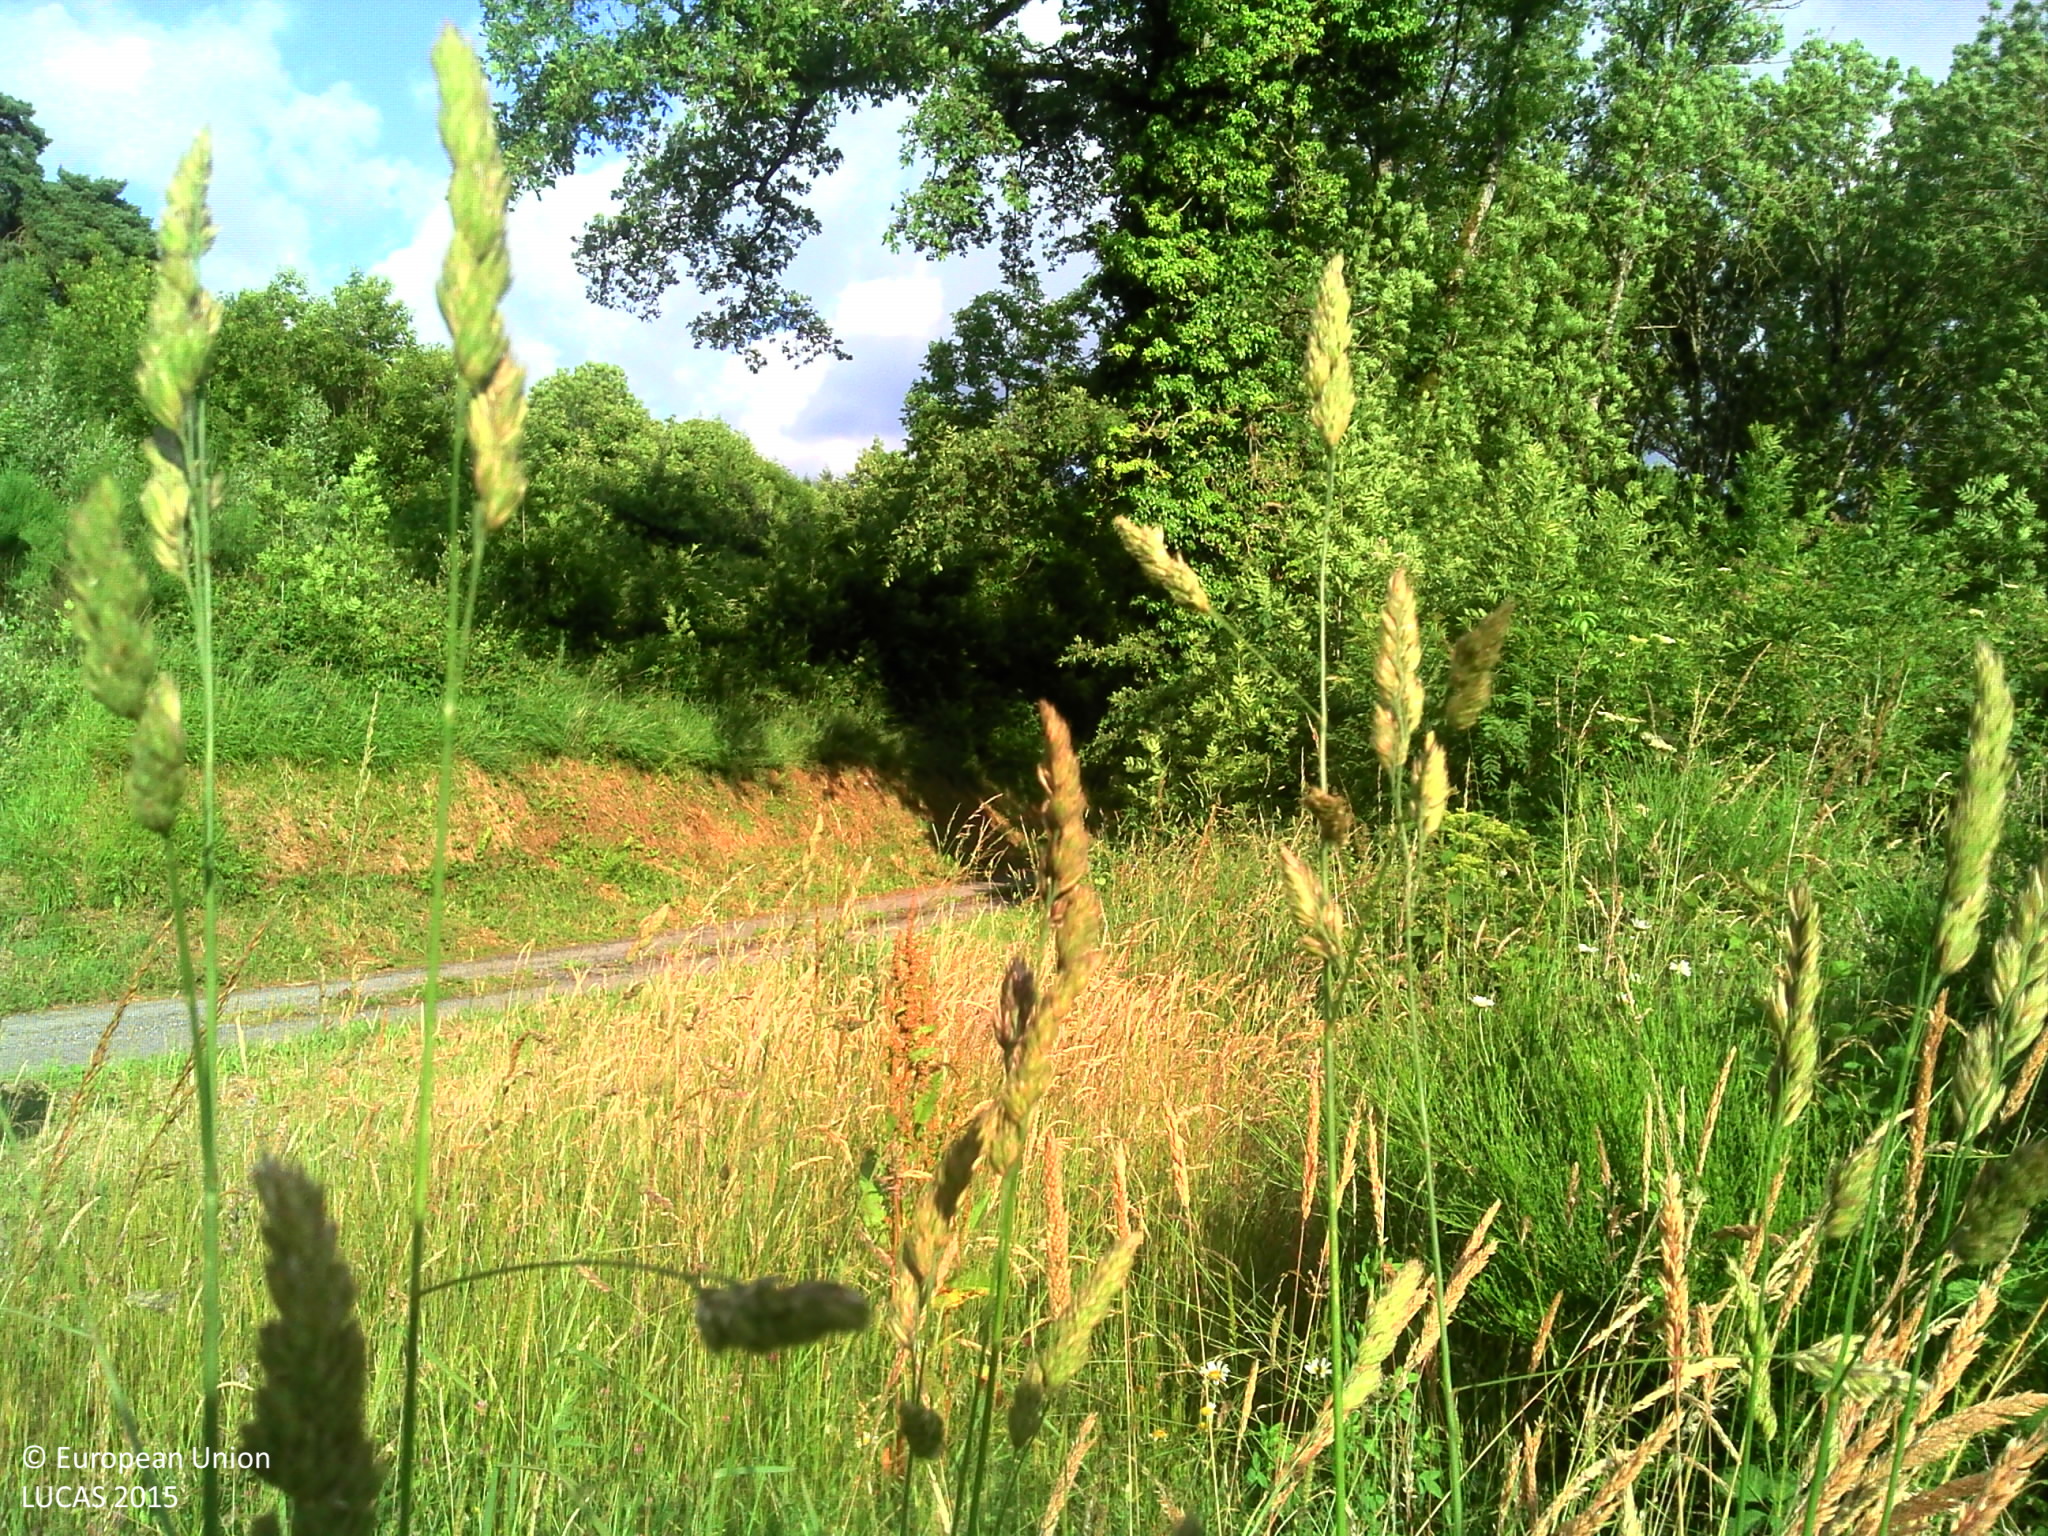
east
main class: Woodland
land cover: Spruce dominated coniferous woodland
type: exotic forest
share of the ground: > 75 %
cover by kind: coniferous forest trees 100 %
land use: Forestry
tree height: > 5 m
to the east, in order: Spruce dominated coniferous woodland; Rivers and streams; Spruce dominated coniferous woodland
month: November
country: FR
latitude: 43.7936
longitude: 2.5615
